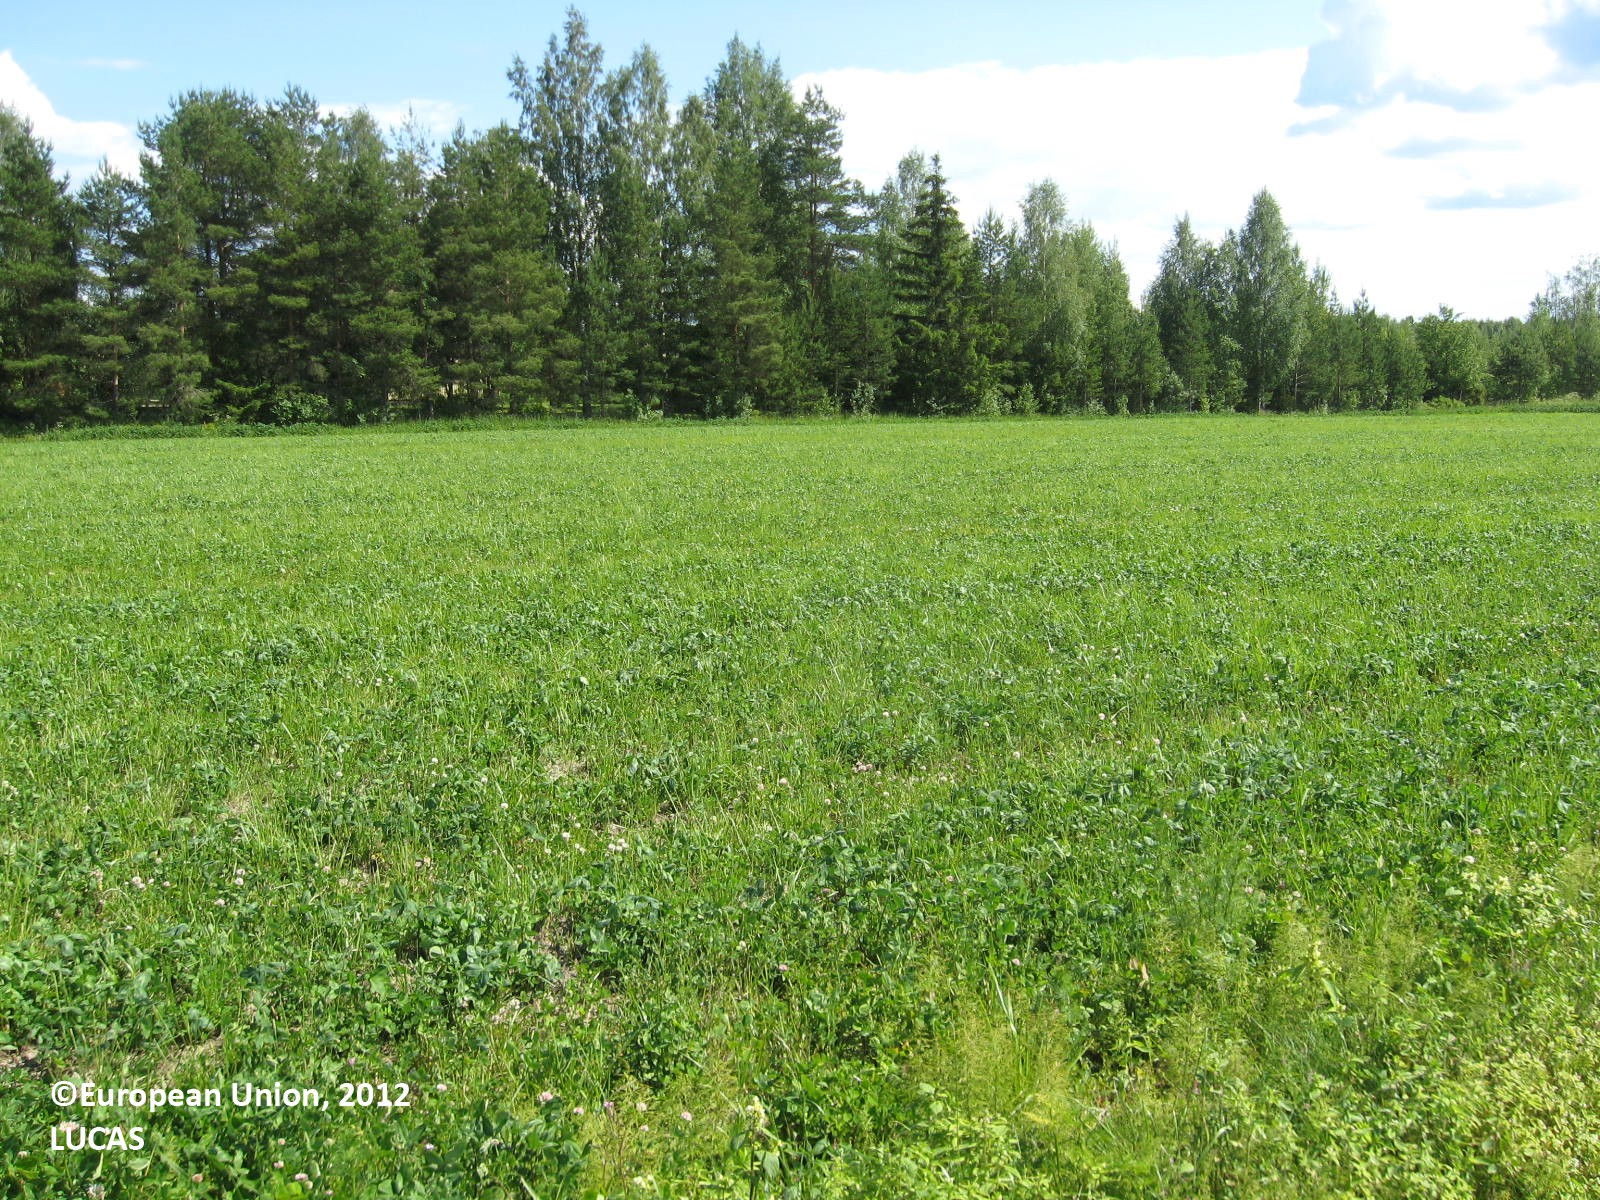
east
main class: Cropland
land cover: Common wheat
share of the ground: > 75 %
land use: Agriculture (excluding fallow land and kitchen gardens)
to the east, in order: Common wheat; Grass margins; Ditches and canals; Grass margins; Mixed cereals for fodder; Other mixed woodland; Fences; Artificial constructions in urban areas; Fences; Paved roads, cycling and walking lanes; Grass margins; Electric lines; Ditches and canals; Broadleaved woodland; Ditches and canals; Shruby margins; Other leguminous and mixtures for fodder; Grass margins; Ditches and canals; Grass margins; Oats
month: July
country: FI
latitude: 62.5804
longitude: 22.5326
